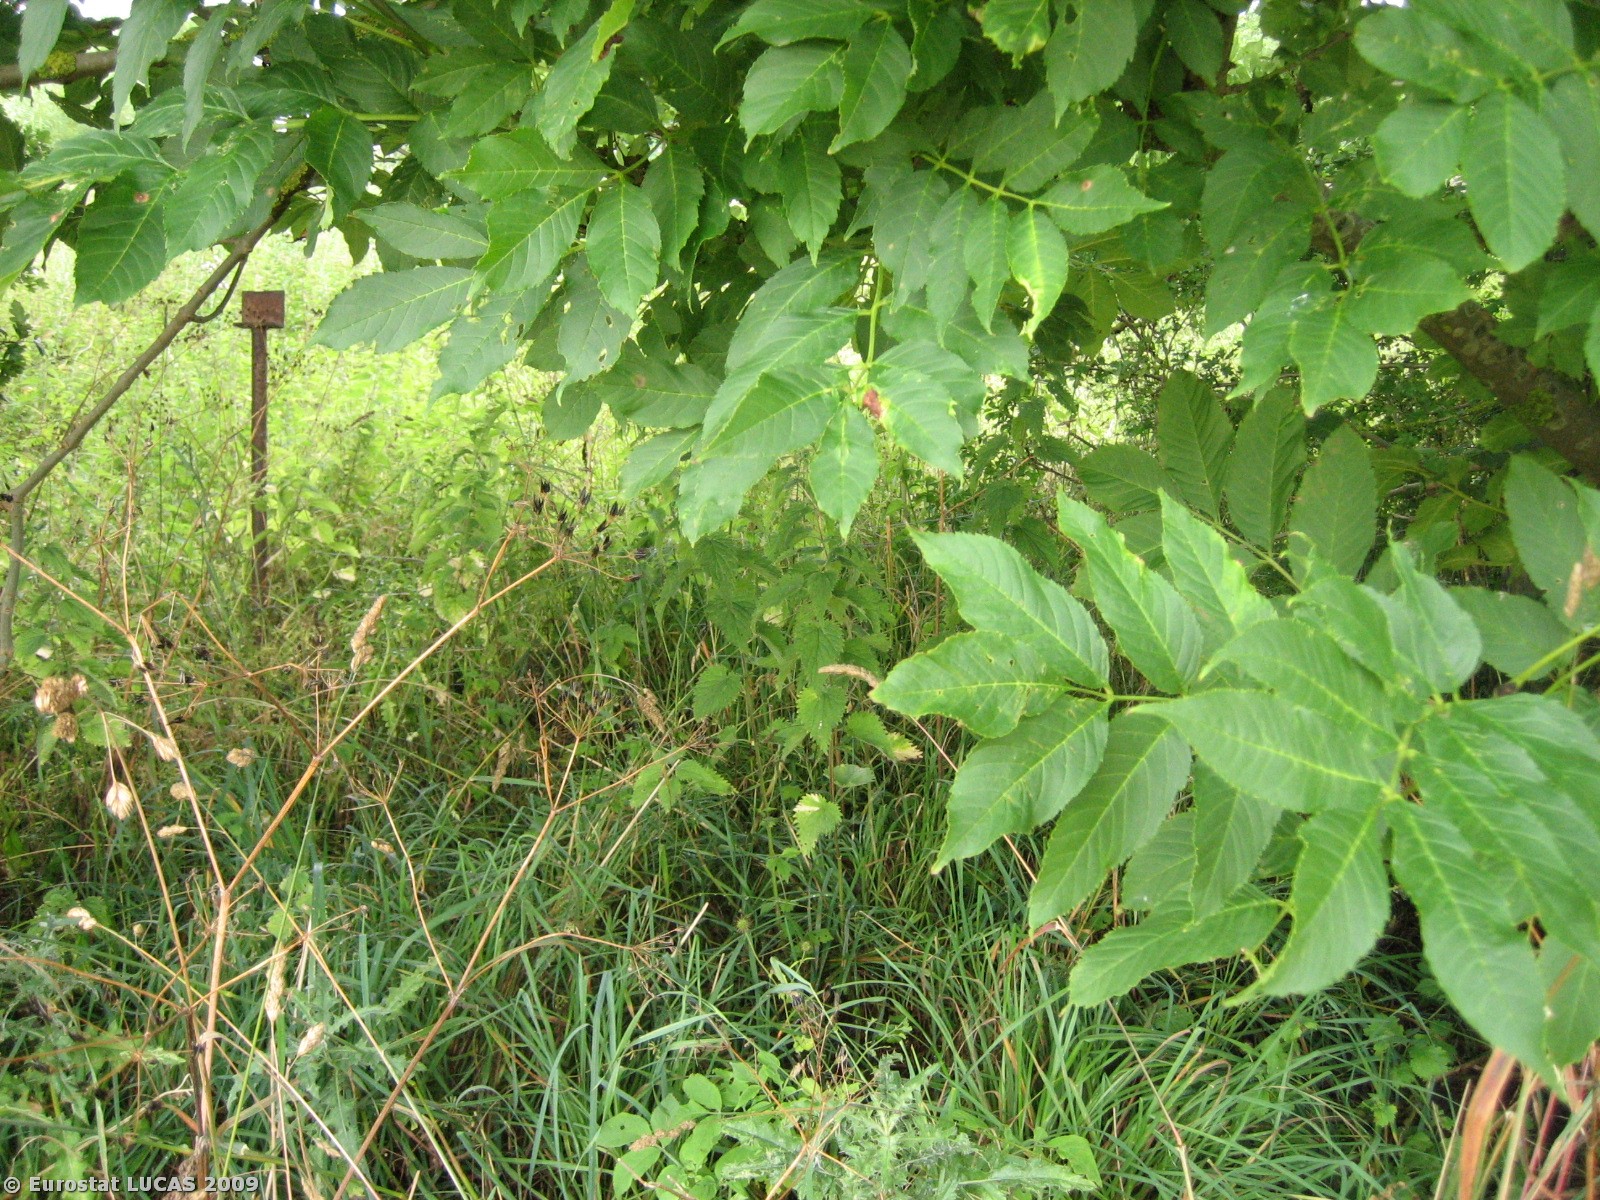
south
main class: Grassland
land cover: Grassland without tree/shrub cover
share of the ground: > 75 %
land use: Unused
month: July
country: DK
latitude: 55.2710
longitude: 9.9843
